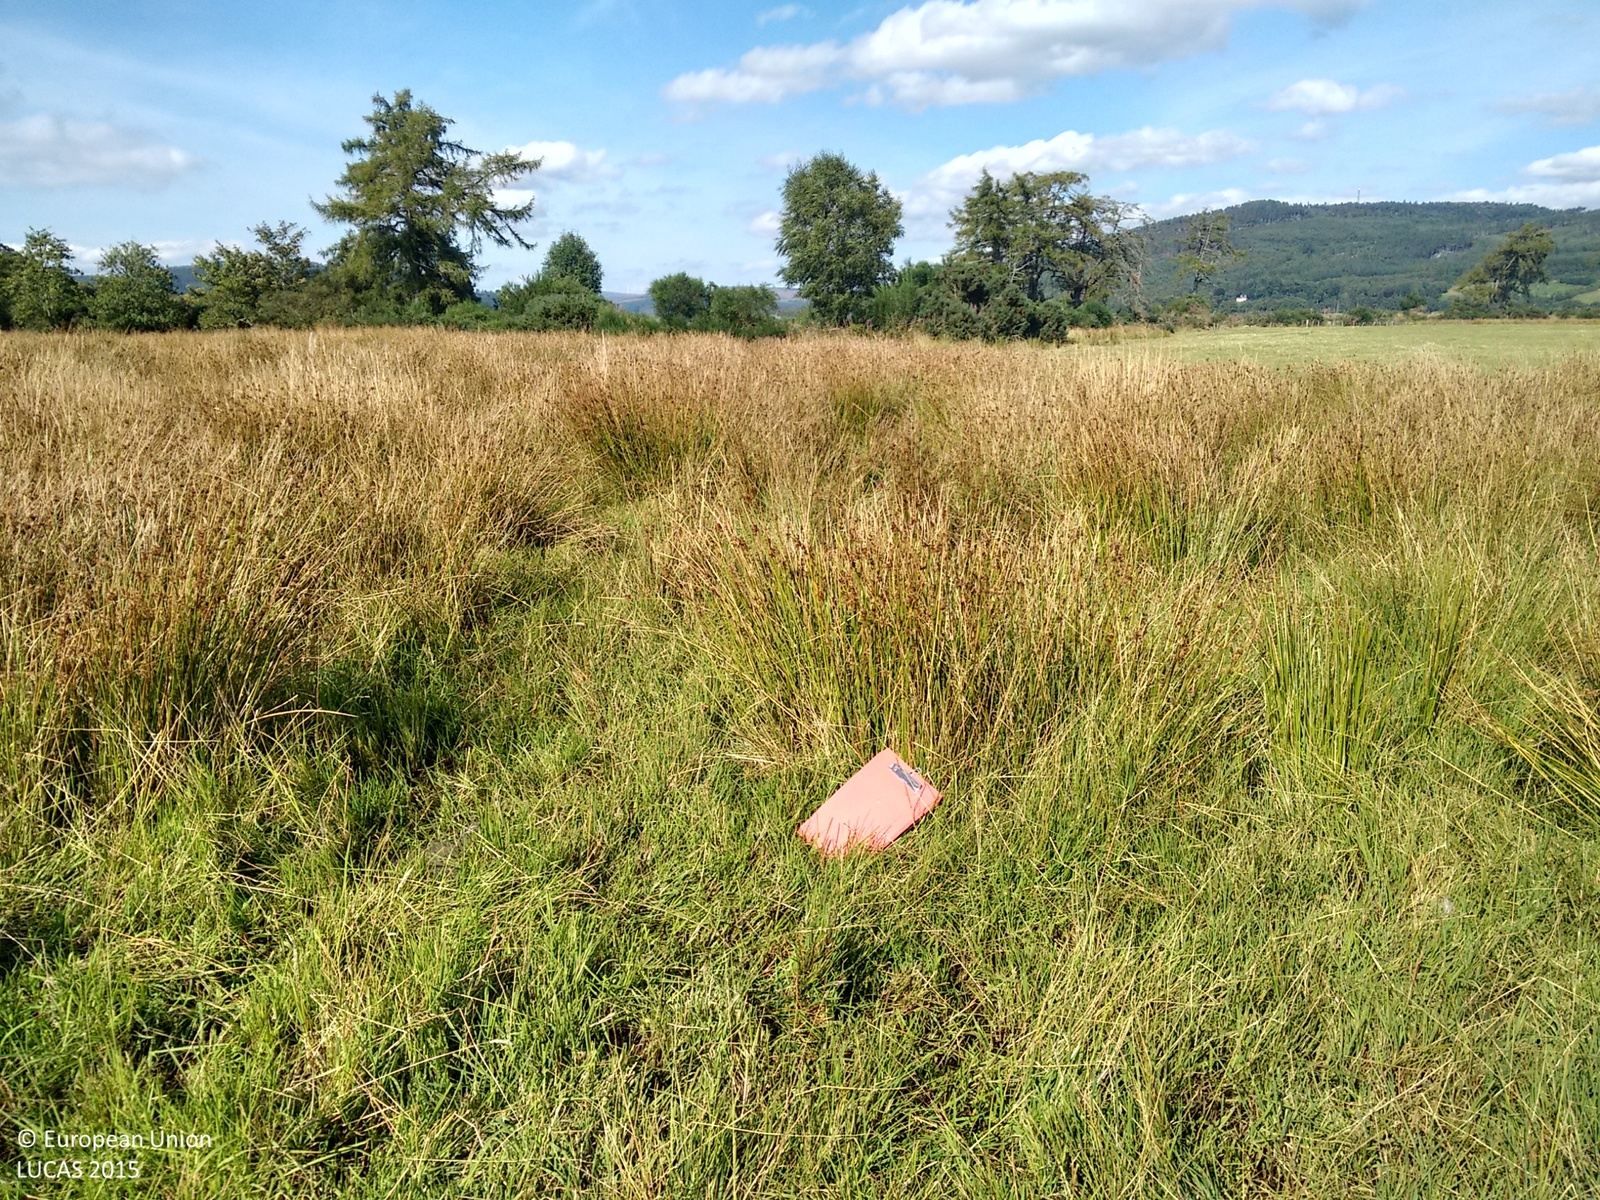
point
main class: Grassland
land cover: Grassland without tree/shrub cover
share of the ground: > 75 %
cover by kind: herbaceous plants 100 %
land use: Agriculture (excluding fallow land and kitchen gardens)
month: September
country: GB
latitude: 57.8987
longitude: -4.3763
